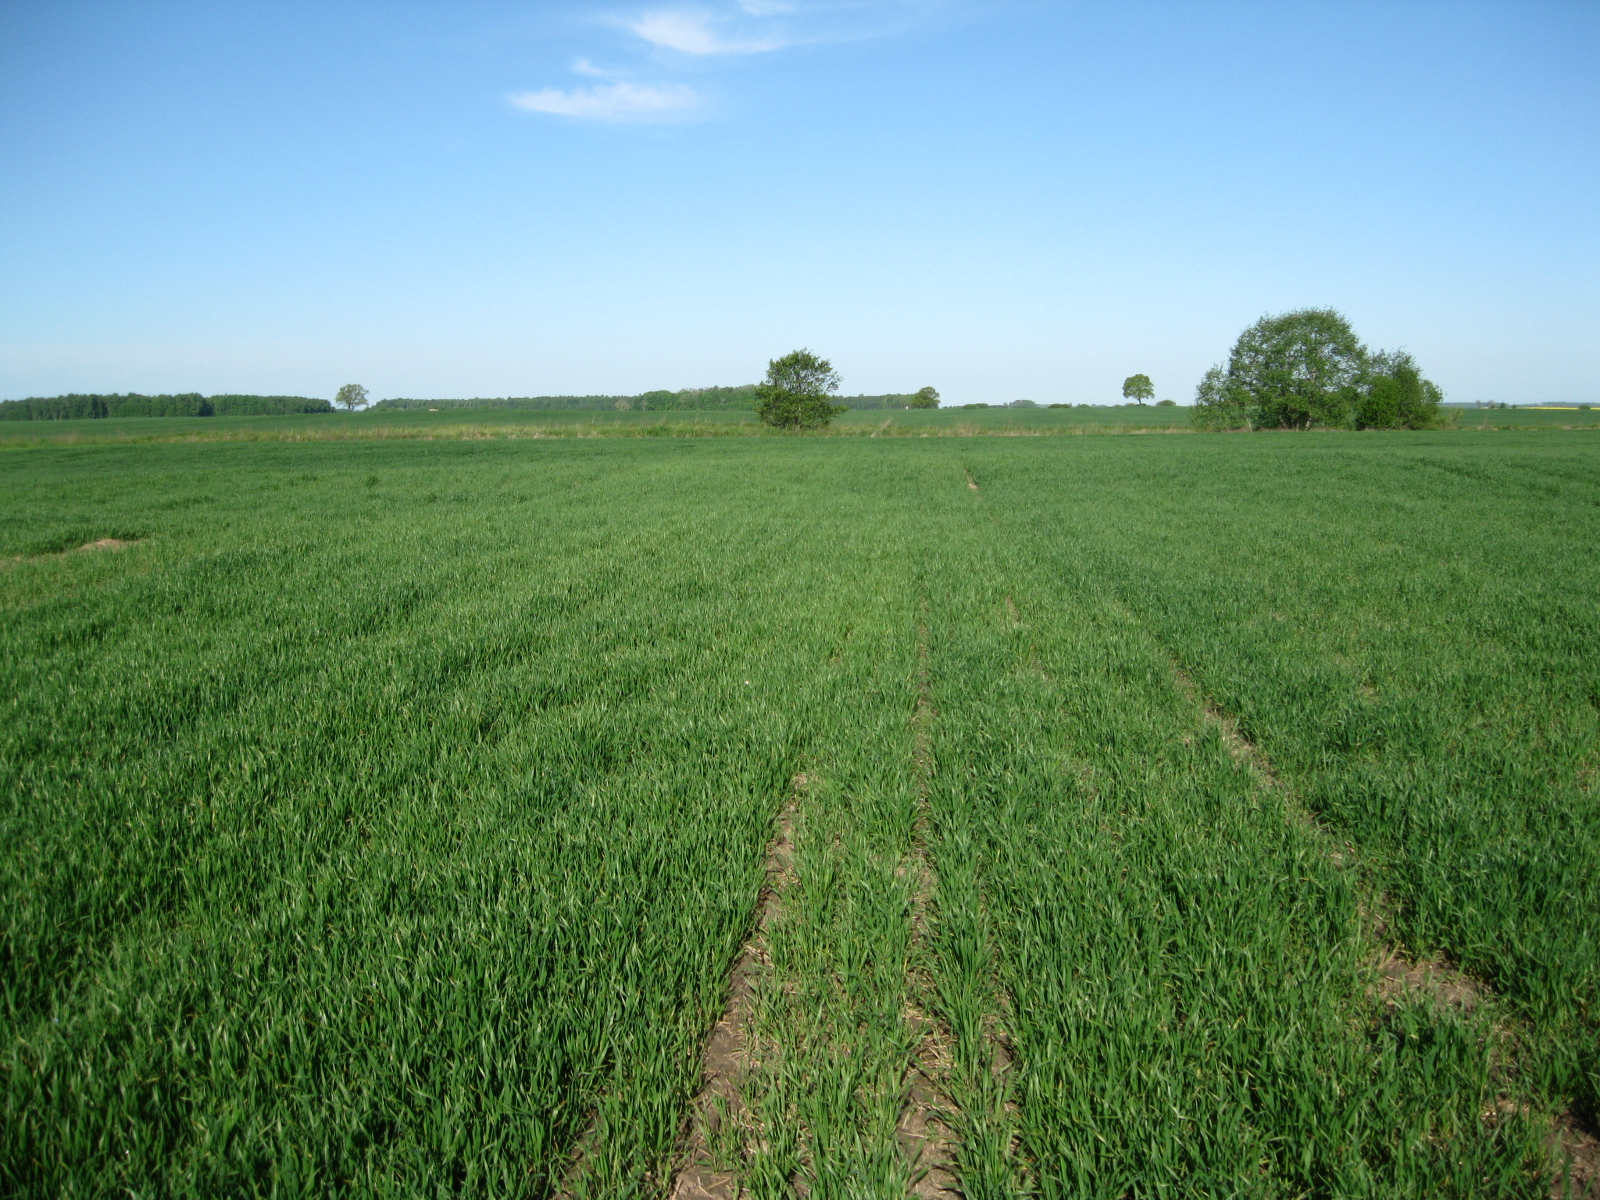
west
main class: Cropland
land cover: Common wheat
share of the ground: > 75 %
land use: Agriculture (excluding fallow land and kitchen gardens)
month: May
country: LT
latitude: 56.1698
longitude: 23.9524
